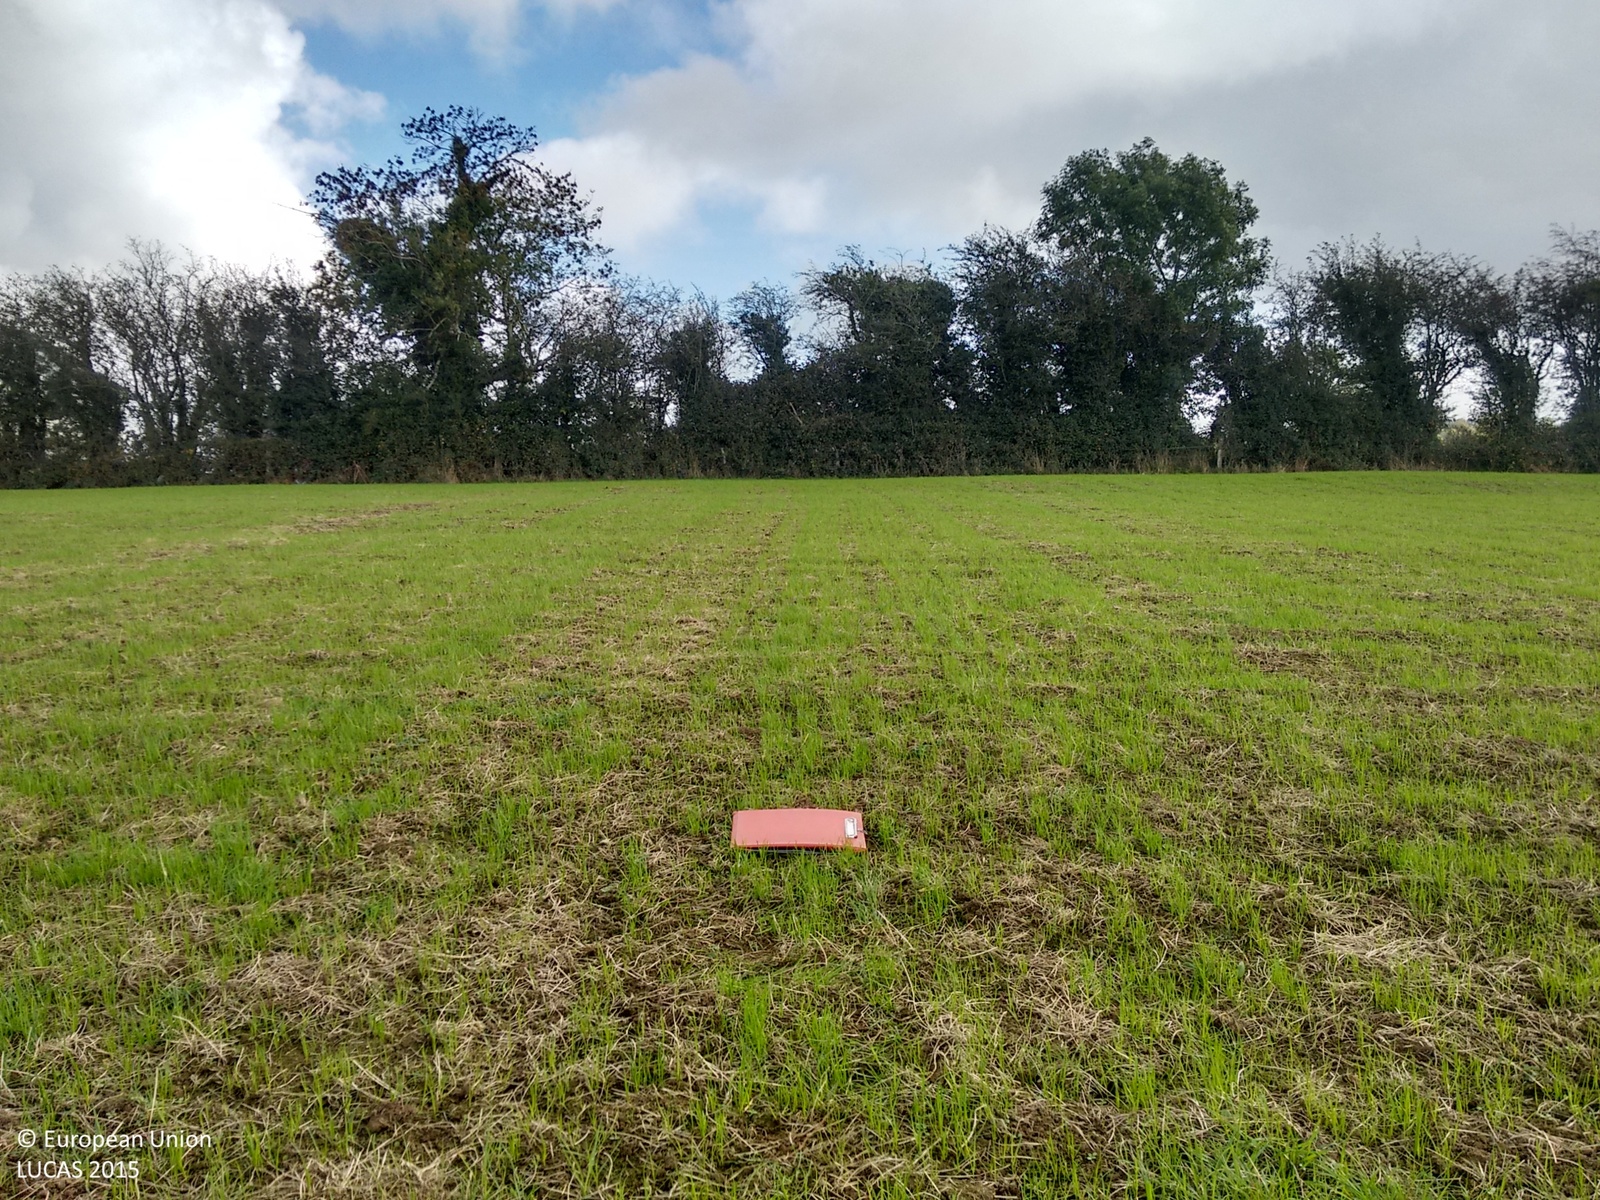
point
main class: Grassland
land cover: Grassland without tree/shrub cover
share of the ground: > 75 %
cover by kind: herbaceous plants 85 %, unconsolidated bare surface 10 %
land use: Agriculture (excluding fallow land and kitchen gardens)
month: October
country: IE
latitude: 53.7794
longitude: -8.0690
